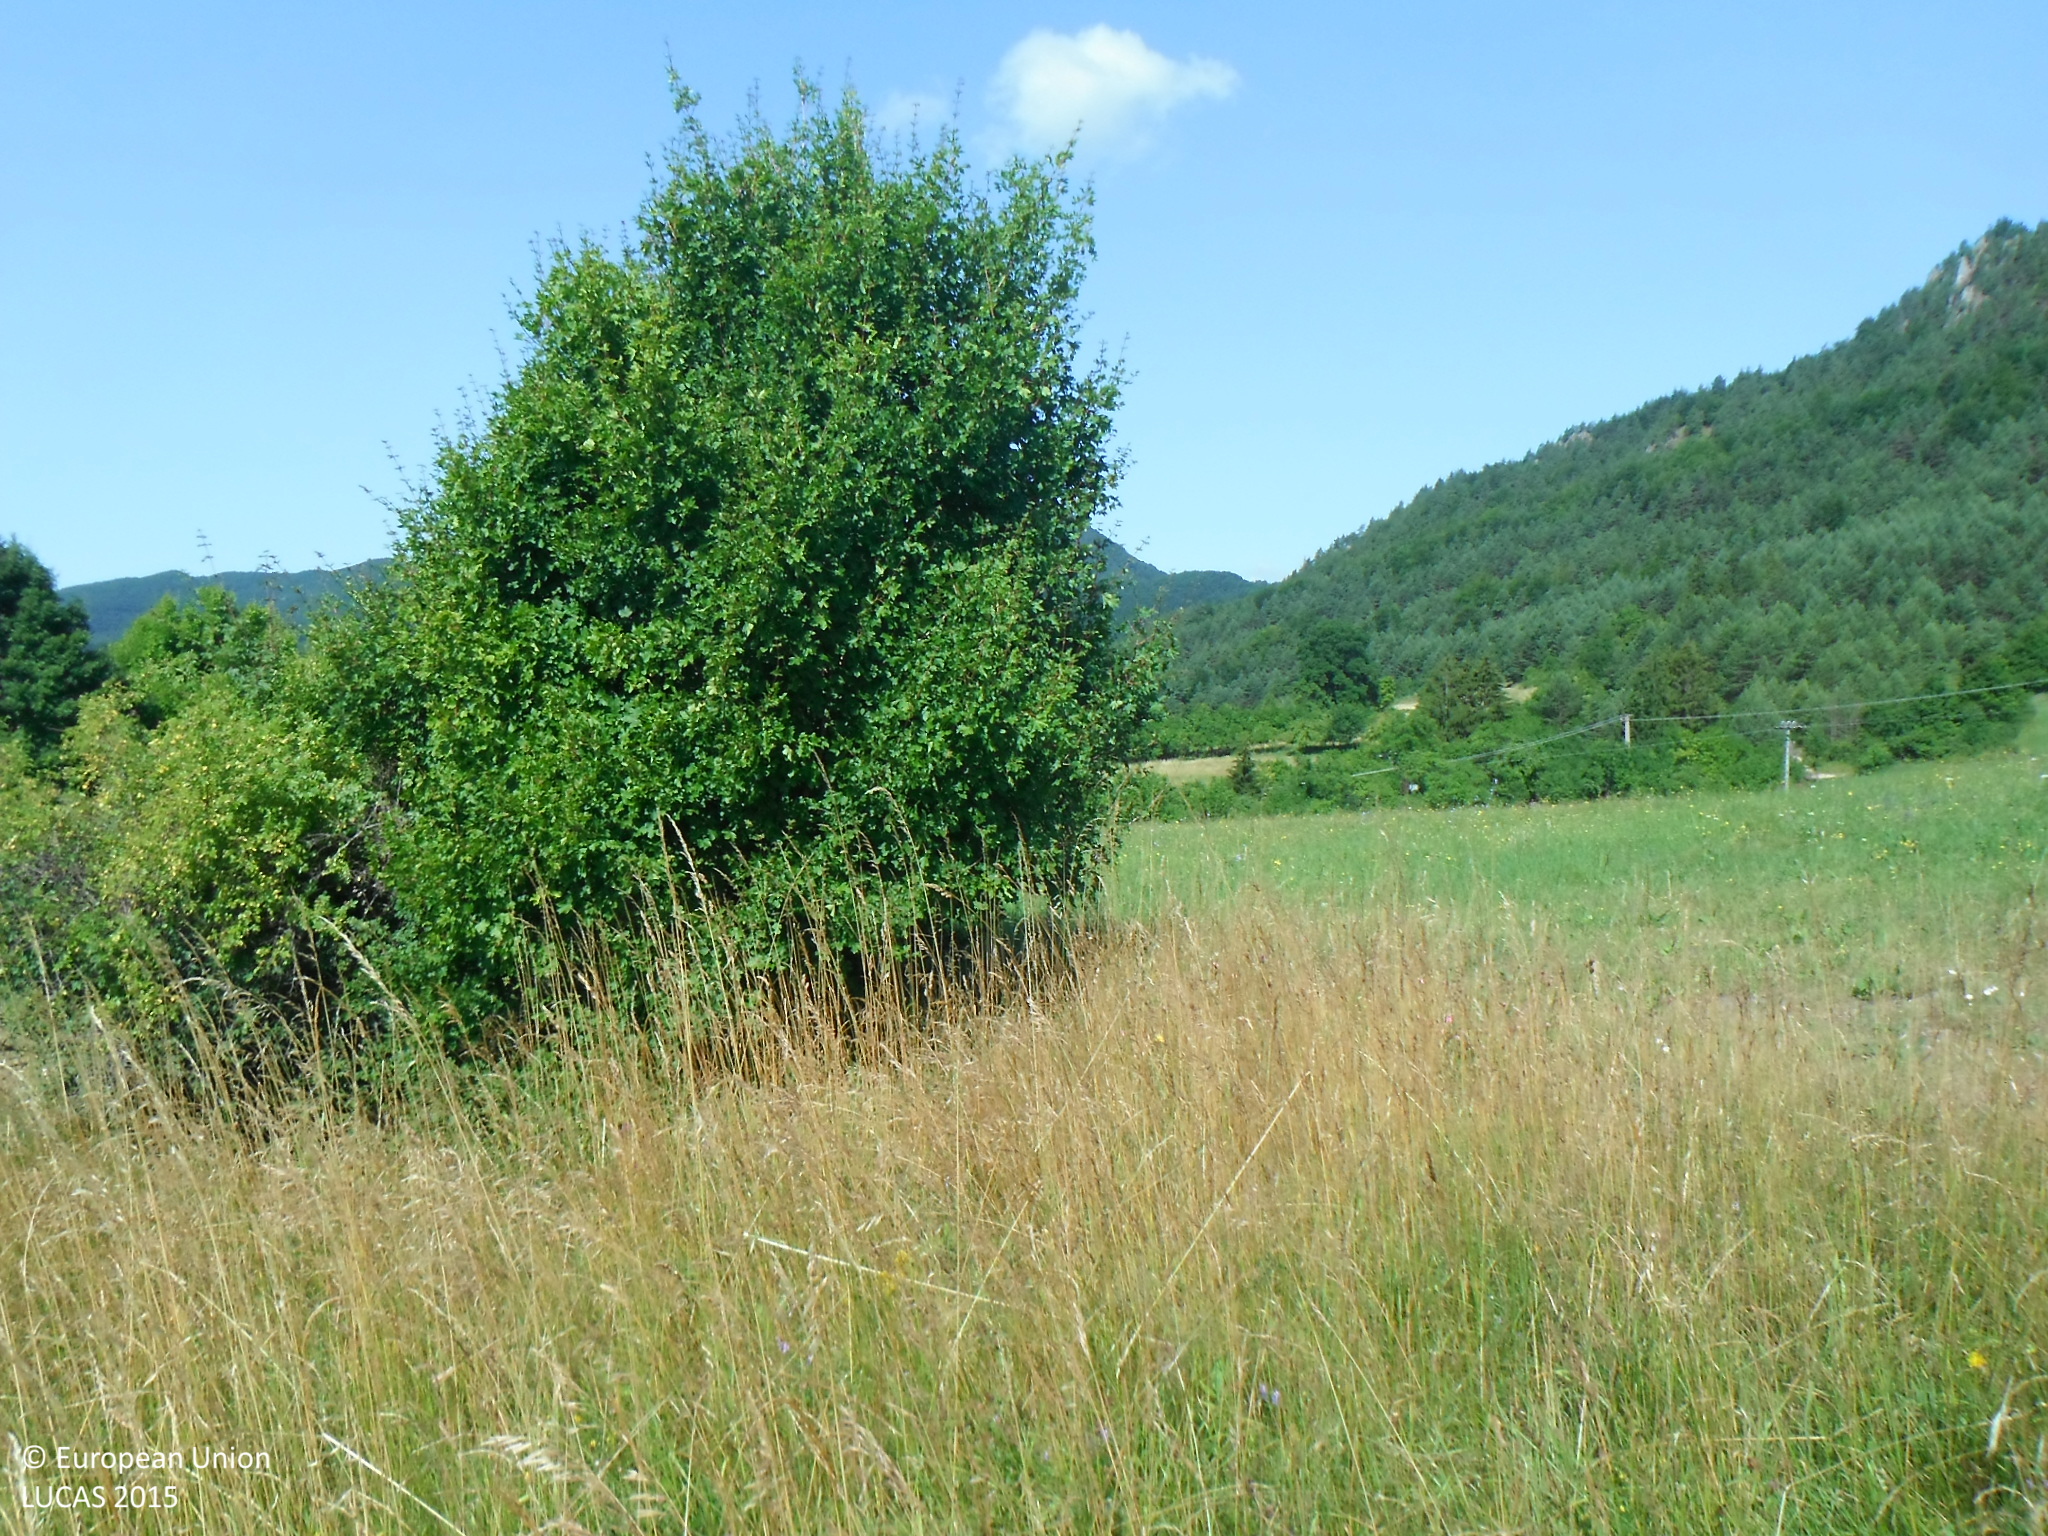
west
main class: Grassland
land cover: Grassland without tree/shrub cover
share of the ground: > 75 %
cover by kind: herbaceous plants 100 %
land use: Agriculture (excluding fallow land and kitchen gardens)
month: July
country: SK
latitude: 49.0199
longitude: 18.4545
